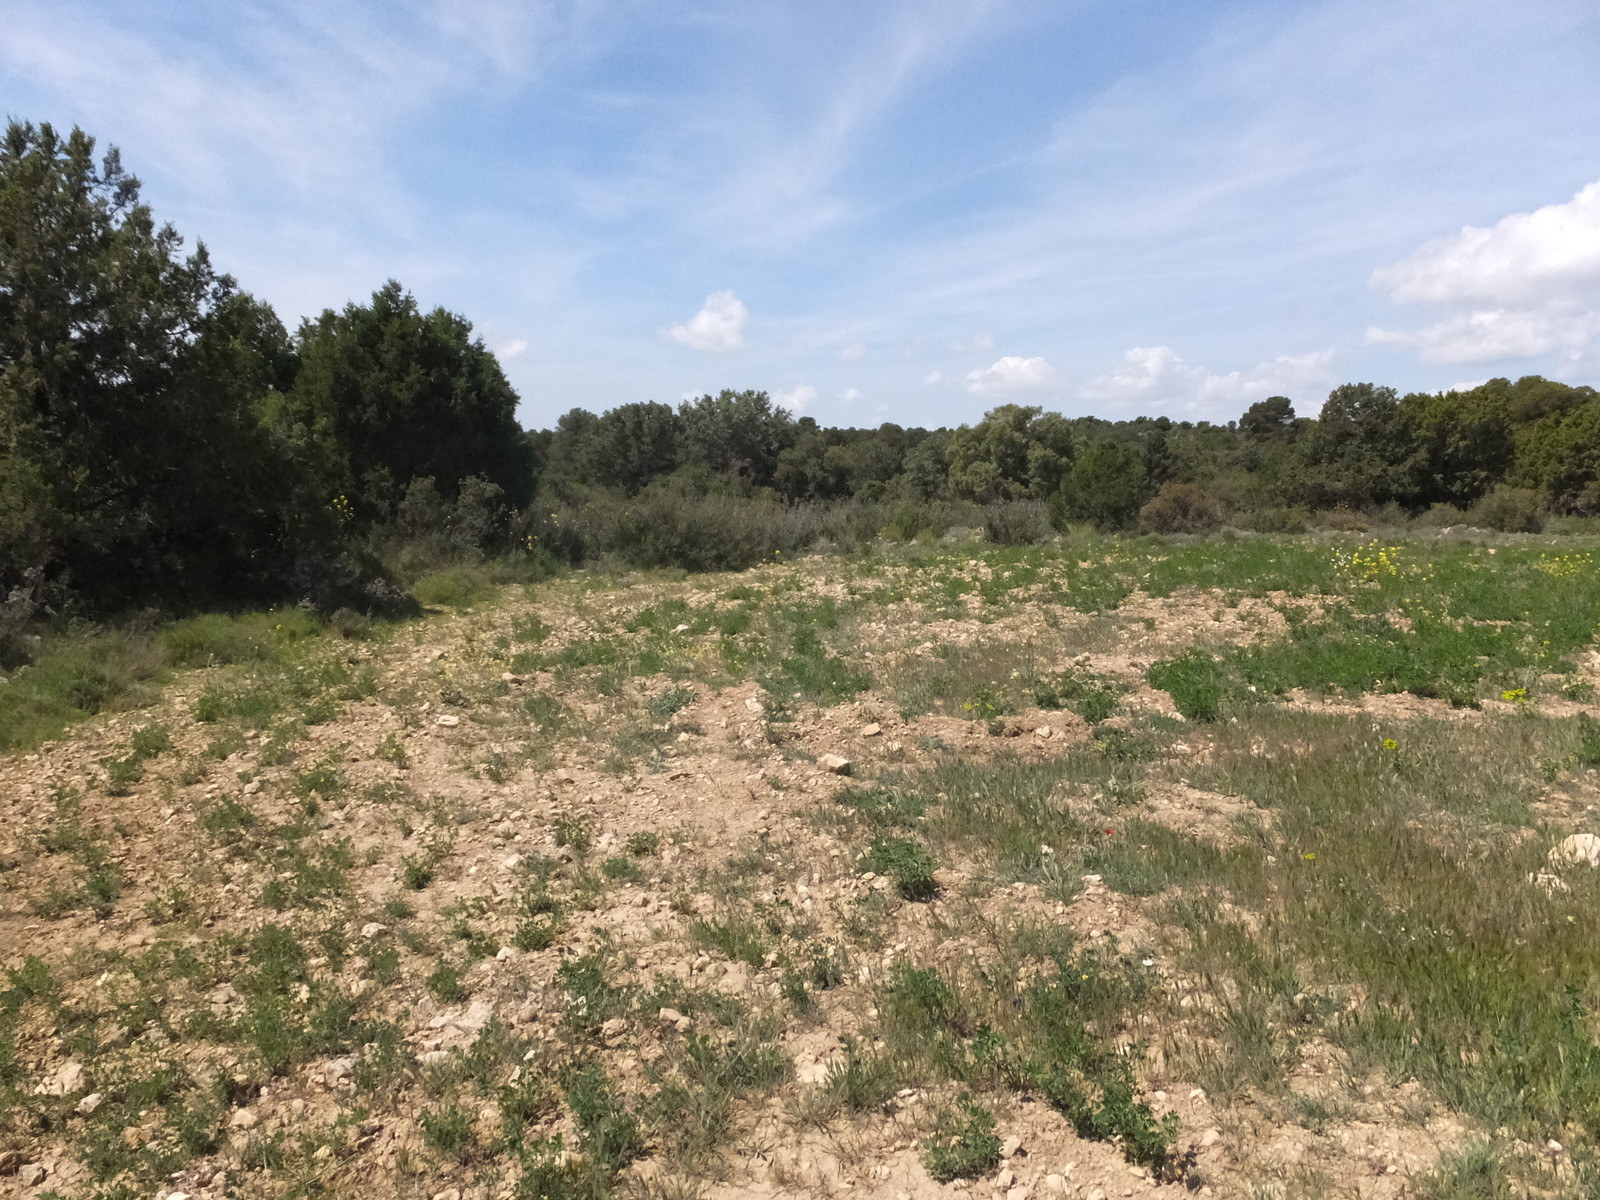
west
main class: Cropland
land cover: Lucerne
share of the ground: > 75 %
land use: Agriculture (excluding fallow land and kitchen gardens)
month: April
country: ES
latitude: 41.6511
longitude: -0.3323
